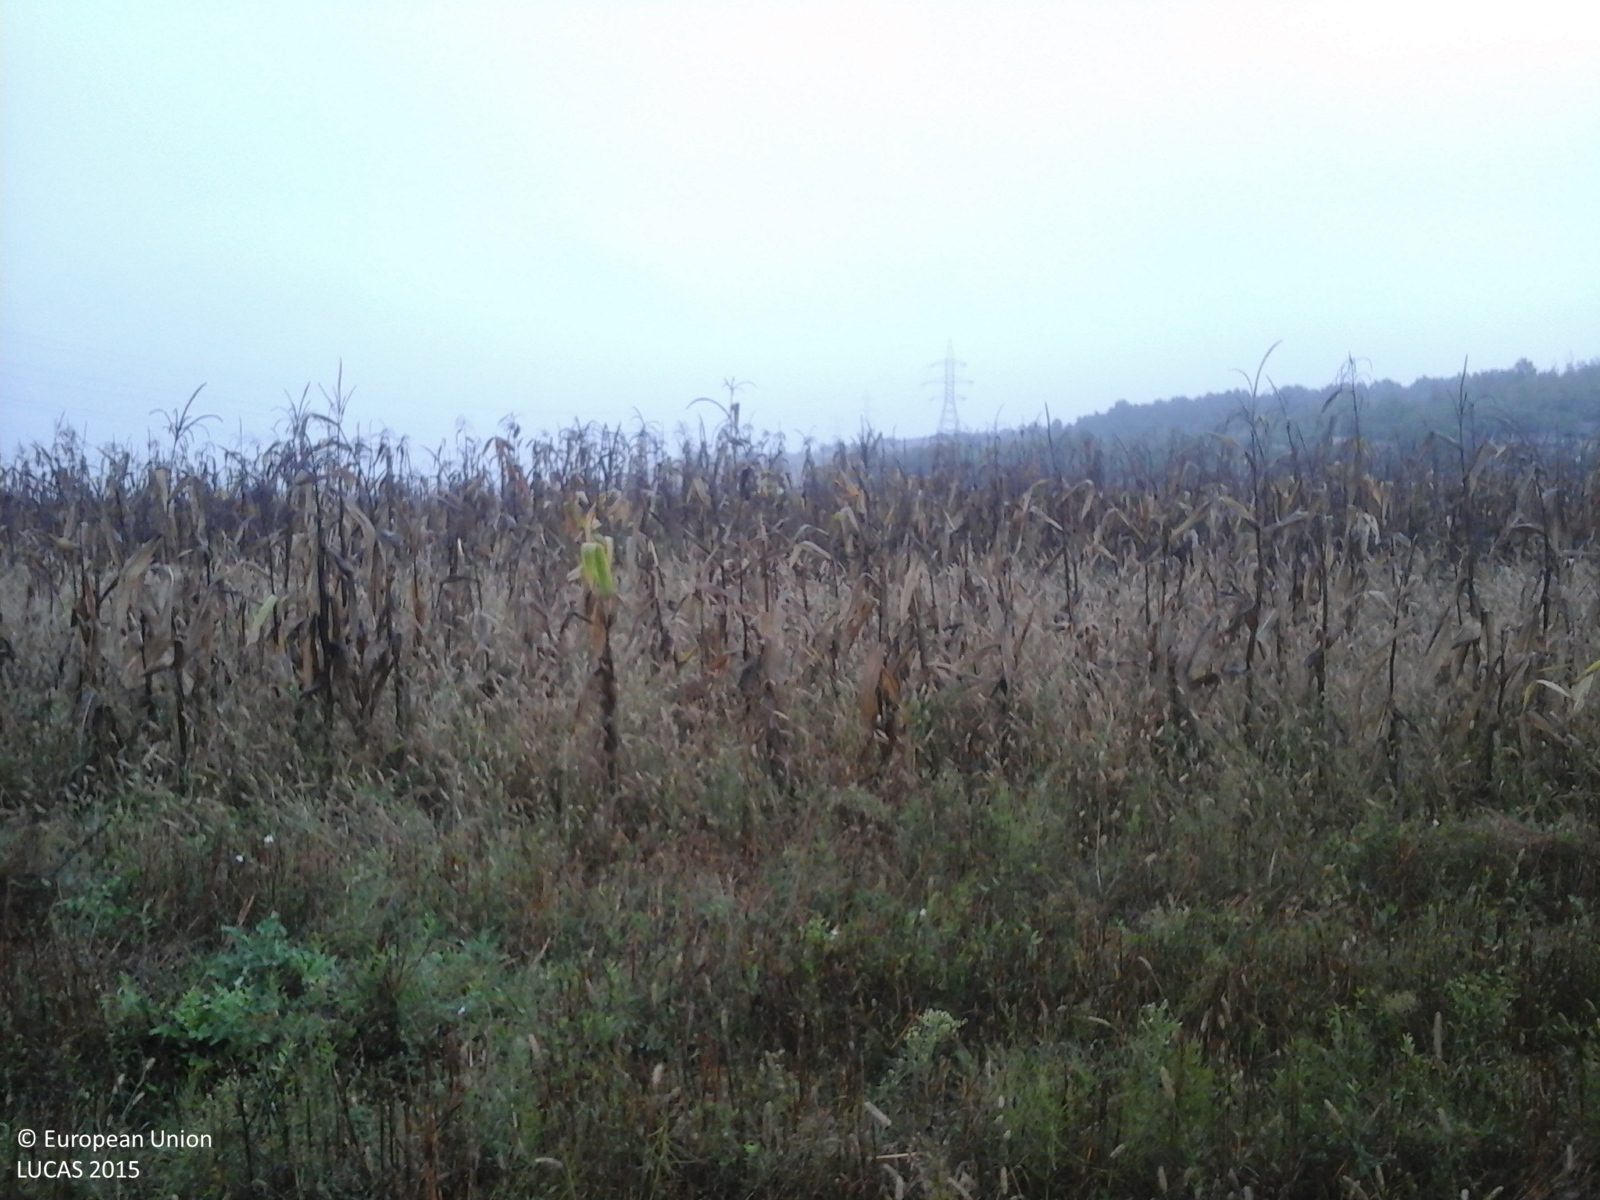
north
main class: Grassland
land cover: Grassland without tree/shrub cover
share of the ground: > 75 %
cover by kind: herbaceous plants 100 %
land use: Agriculture (excluding fallow land and kitchen gardens)
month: September
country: RO
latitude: 44.9217
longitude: 23.5238
